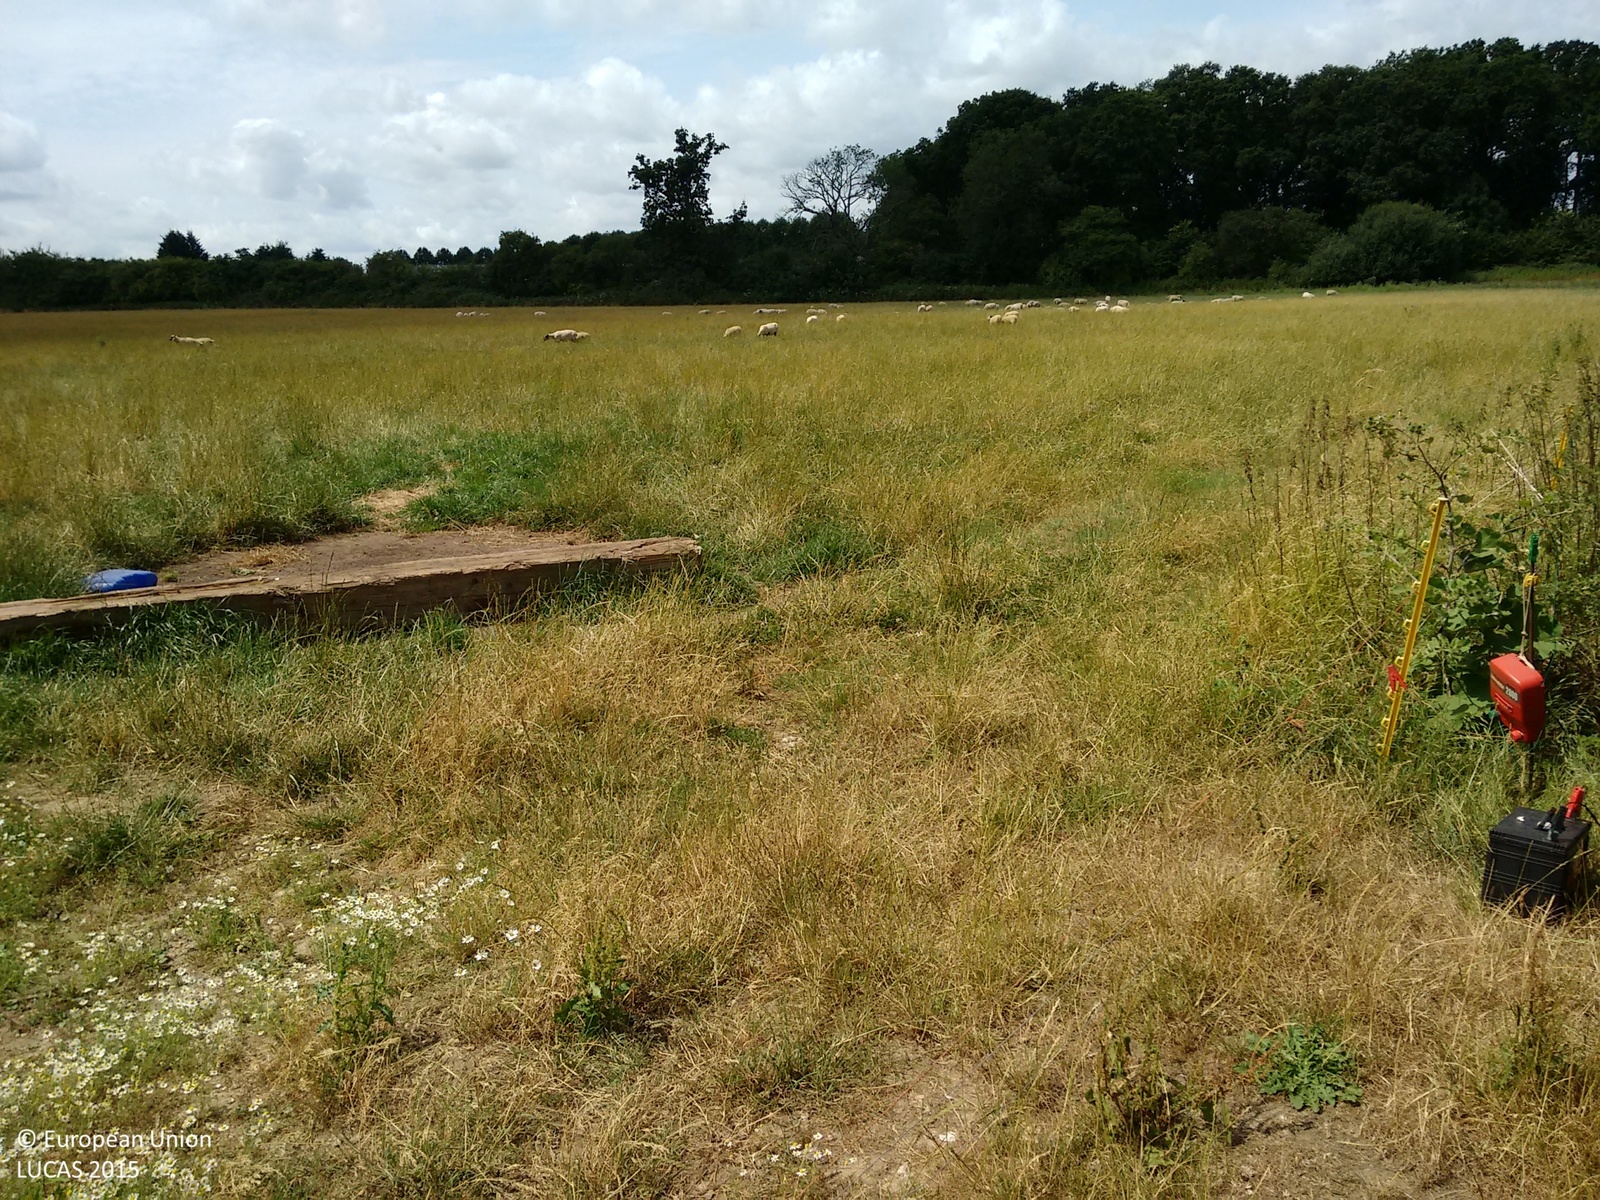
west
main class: Grassland
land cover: Grassland without tree/shrub cover
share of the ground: > 75 %
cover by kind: herbaceous plants 100 %
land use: Agriculture (excluding fallow land and kitchen gardens)
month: July
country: GB
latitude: 51.2768
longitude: -0.4887
